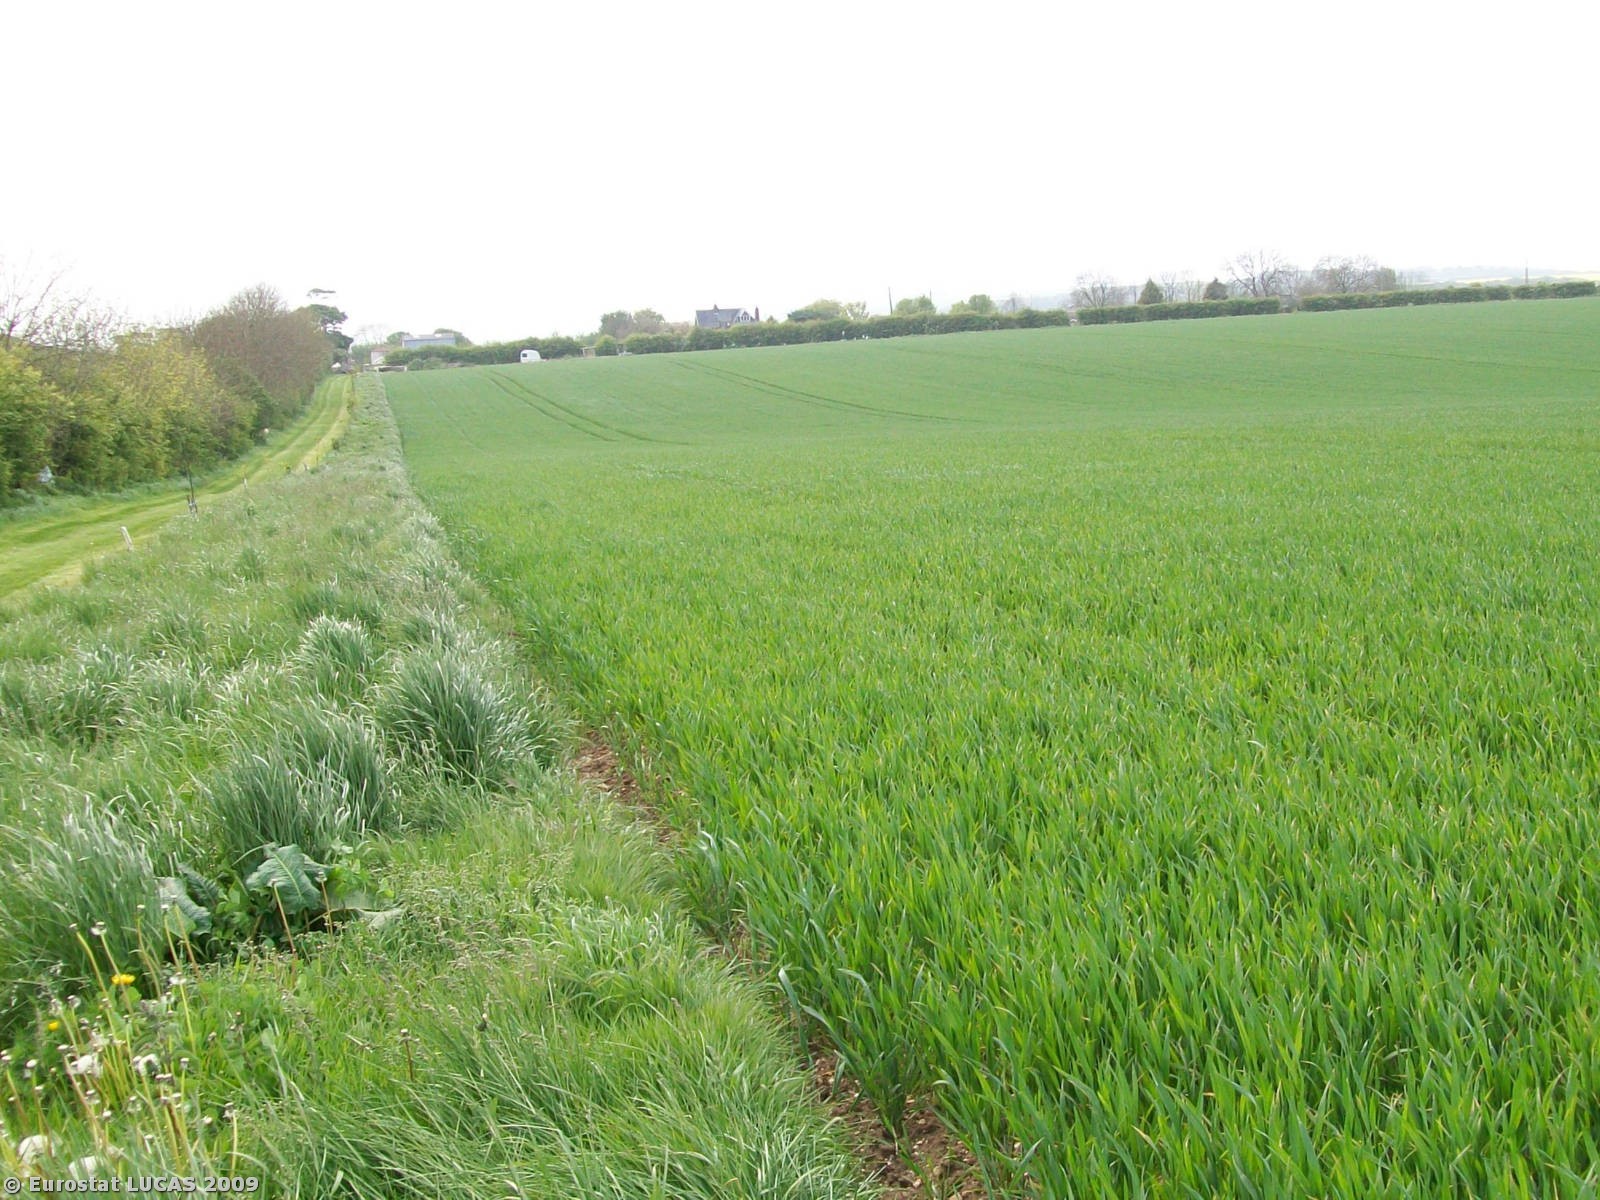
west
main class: Cropland
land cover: Common wheat
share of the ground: > 75 %
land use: Agriculture (excluding fallow land and kitchen gardens)
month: May
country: GB
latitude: 54.1371
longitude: -0.3354
